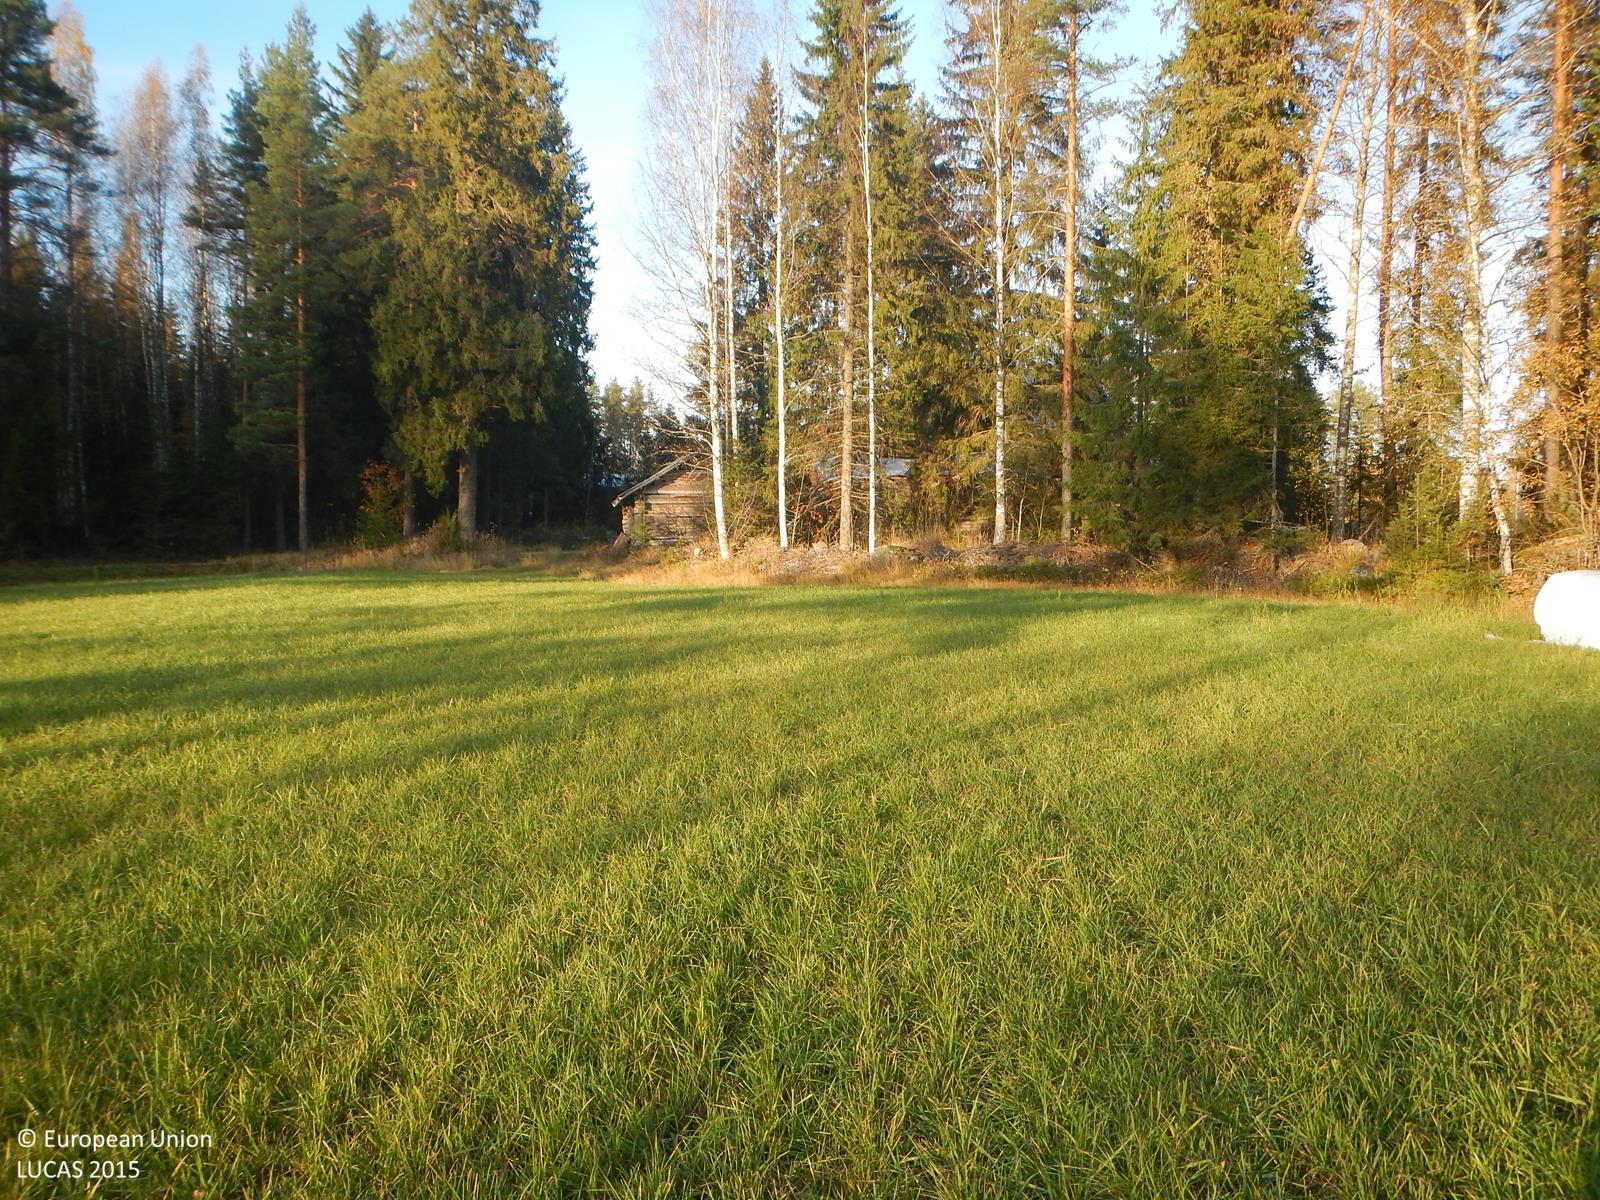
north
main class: Cropland
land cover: Temporary grasslands
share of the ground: > 75 %
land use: Agriculture (excluding fallow land and kitchen gardens)
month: October
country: FI
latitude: 62.1639
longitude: 26.0824
